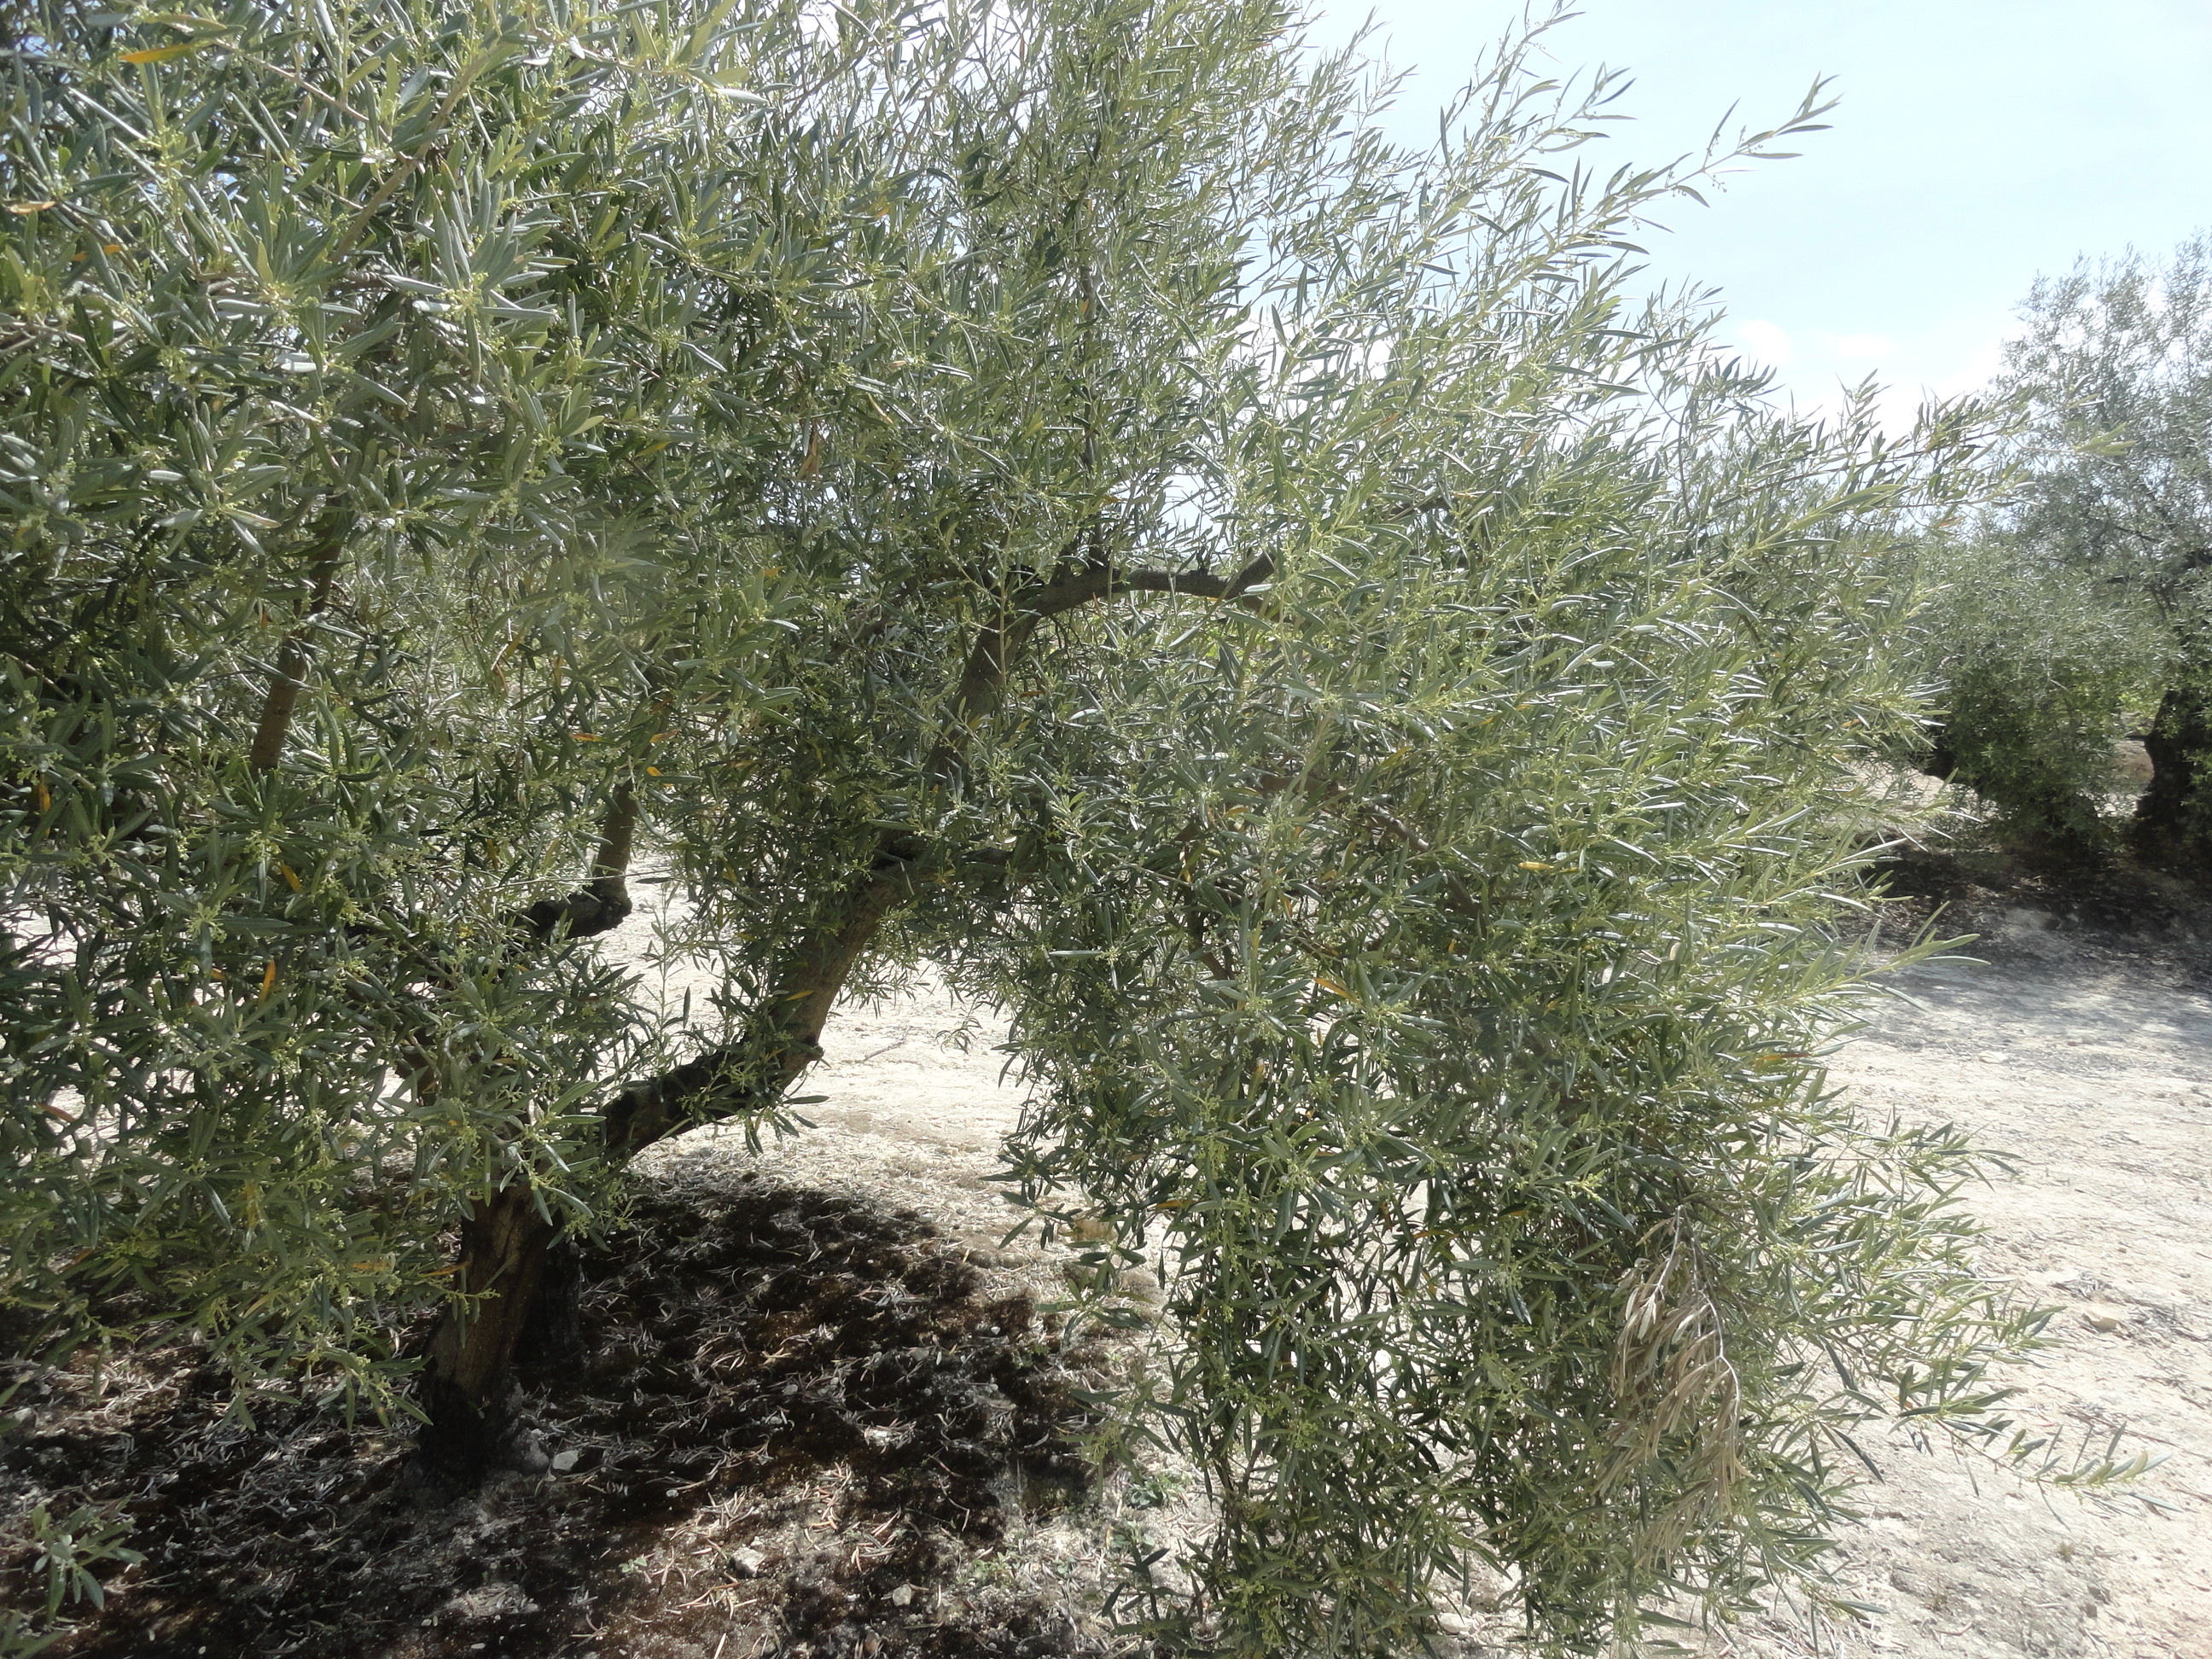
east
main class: Cropland
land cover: Olive groves
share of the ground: 25 - 50 %
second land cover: Other bare soil
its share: > 75 %
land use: Agriculture (excluding fallow land and kitchen gardens)
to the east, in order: Olive groves; Other bare soil; Tracks; Vineyards; Olive groves; Vineyards; Olive groves; Grass margins
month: April
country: ES
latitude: 37.5560
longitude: -4.5750
